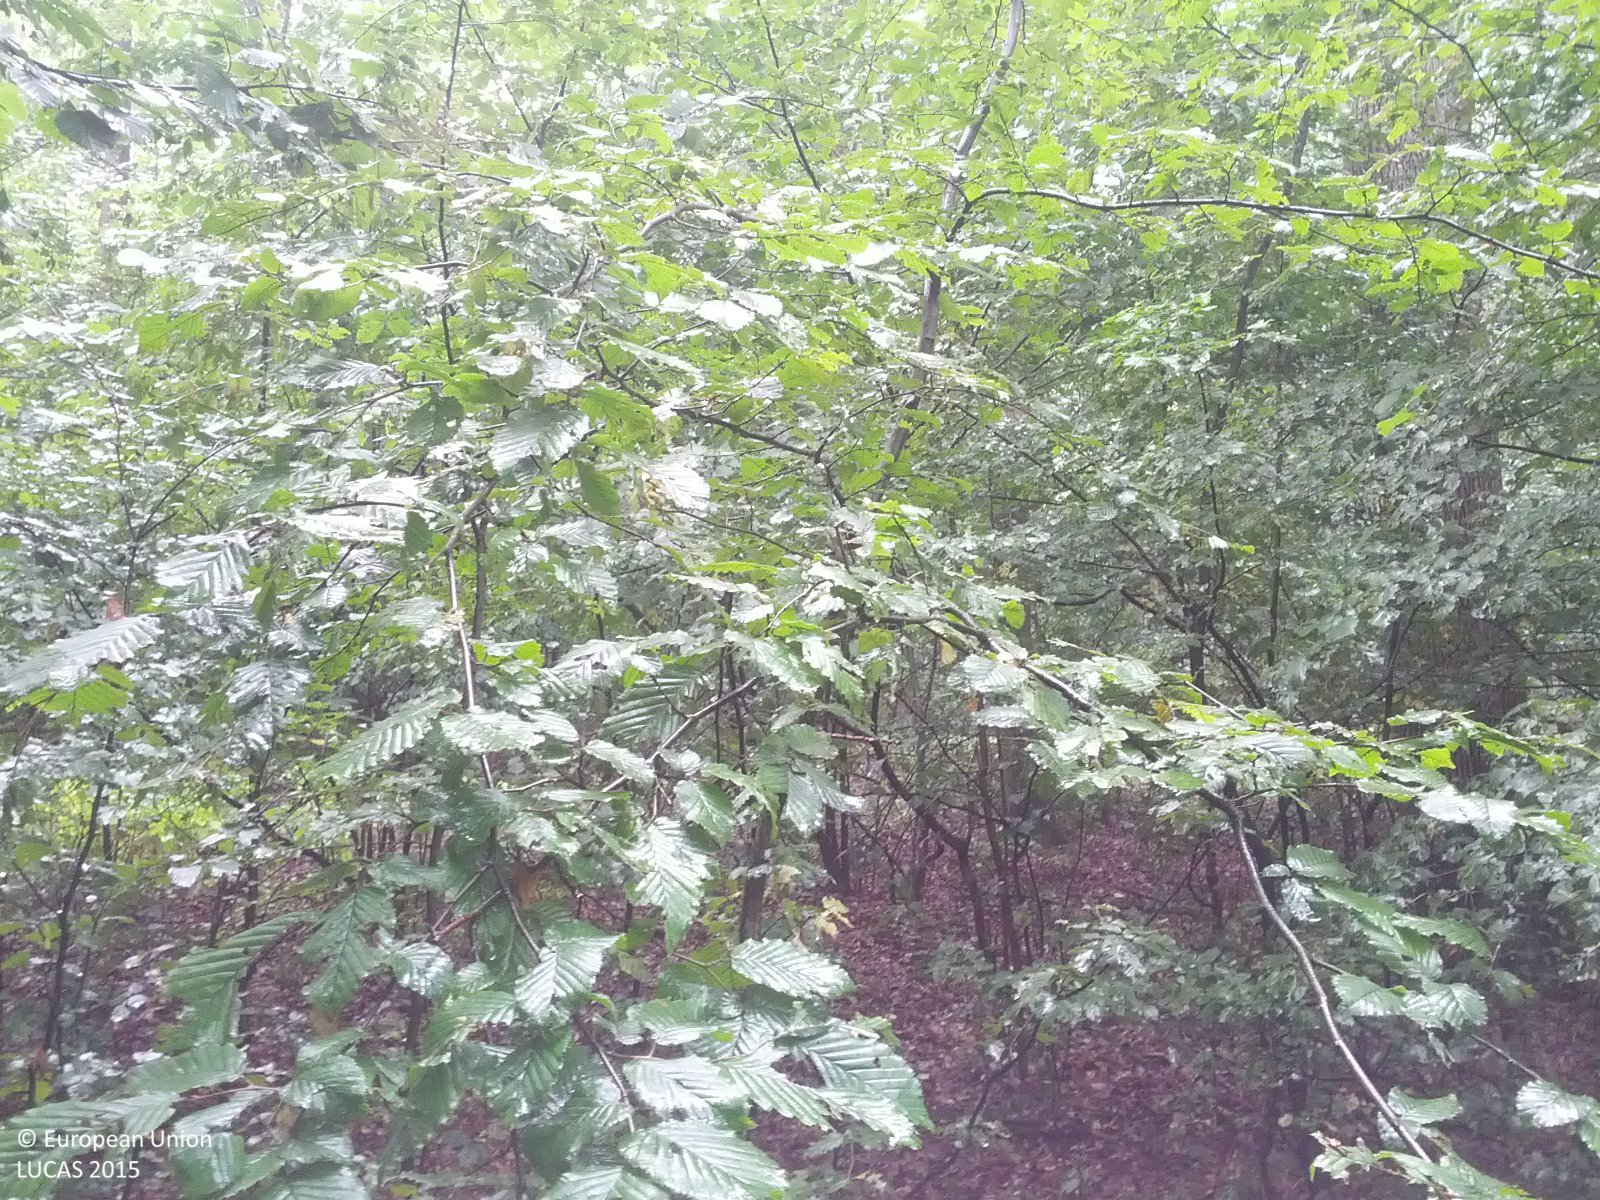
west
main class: Woodland
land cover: Broadleaved woodland
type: acidophilous oak and oak-birch forest
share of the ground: > 75 %
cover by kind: broadleaved forest trees 80 %, shrubs 10 %, herbaceous plants 10 %
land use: Forestry
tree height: > 5 m
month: July
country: AT
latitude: 48.5469
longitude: 16.3315
